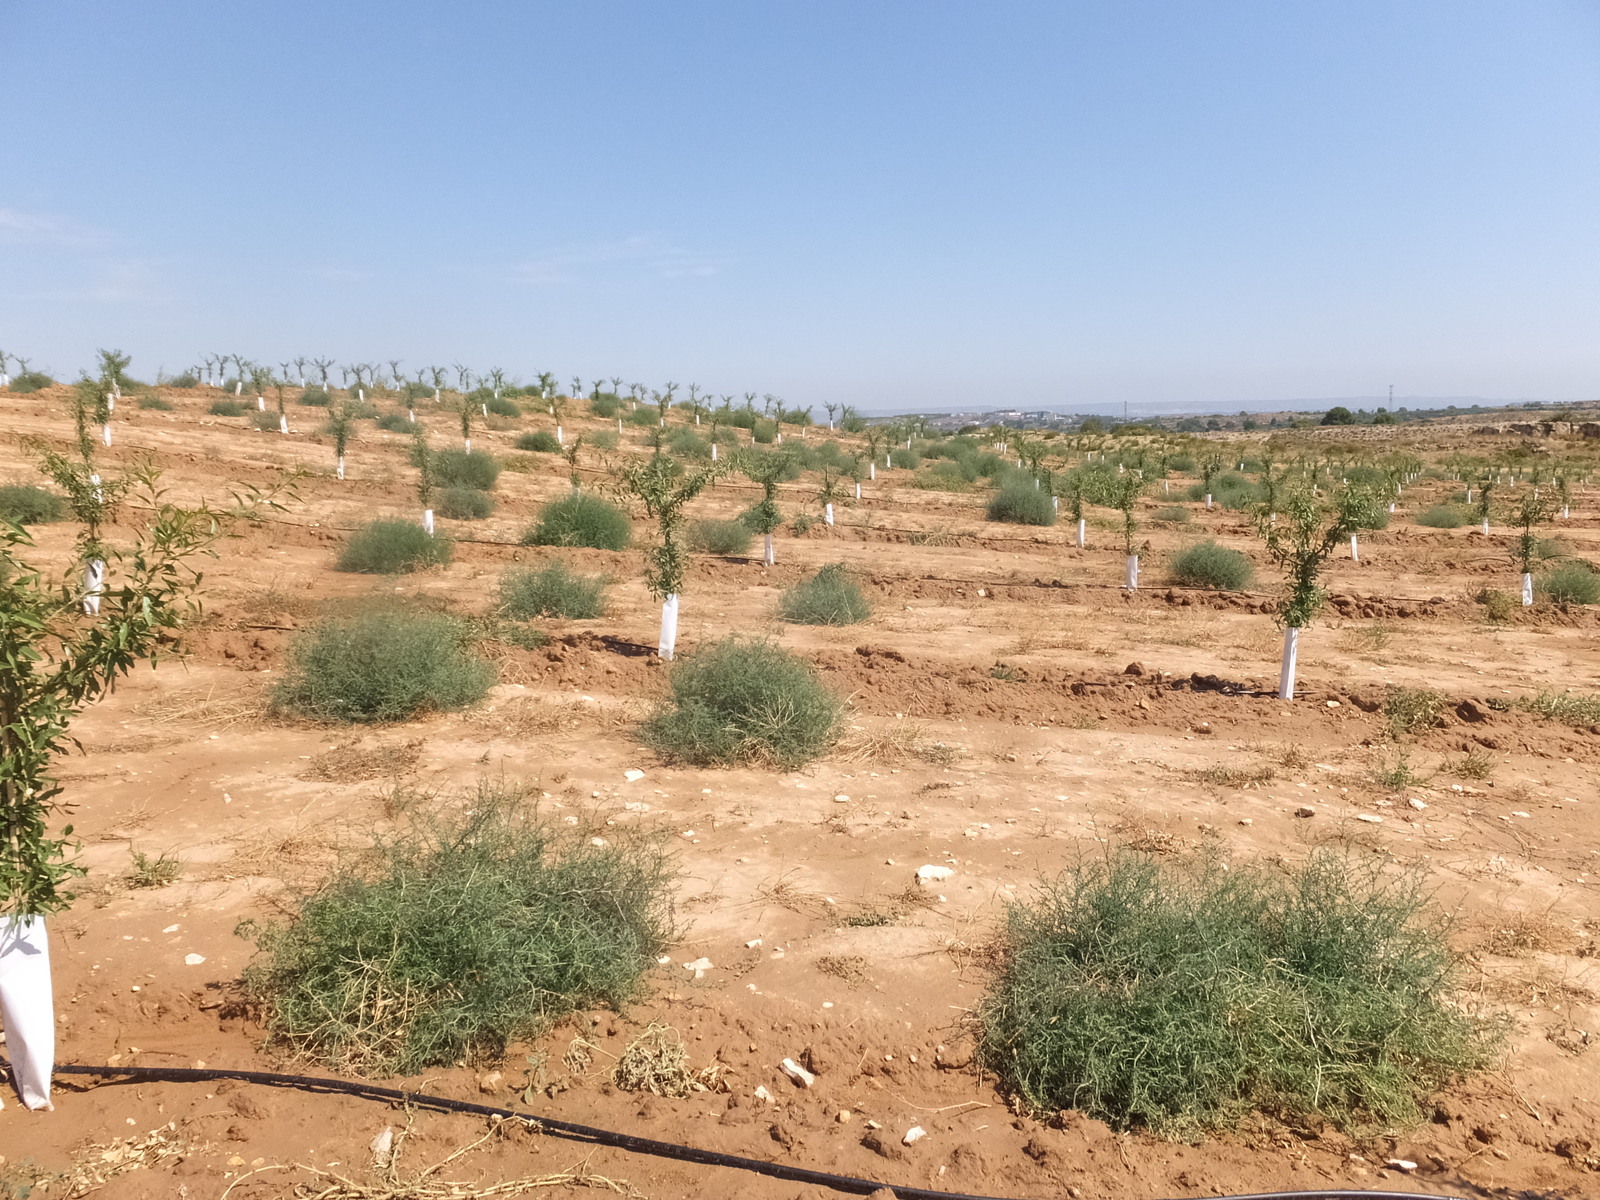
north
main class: Cropland
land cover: Nuts trees
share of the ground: 10 - 25 %
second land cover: Spontaneously vegetated surfaces
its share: < 10 %
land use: Agriculture (excluding fallow land and kitchen gardens)
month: July
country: ES
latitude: 41.1898
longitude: -0.0391
